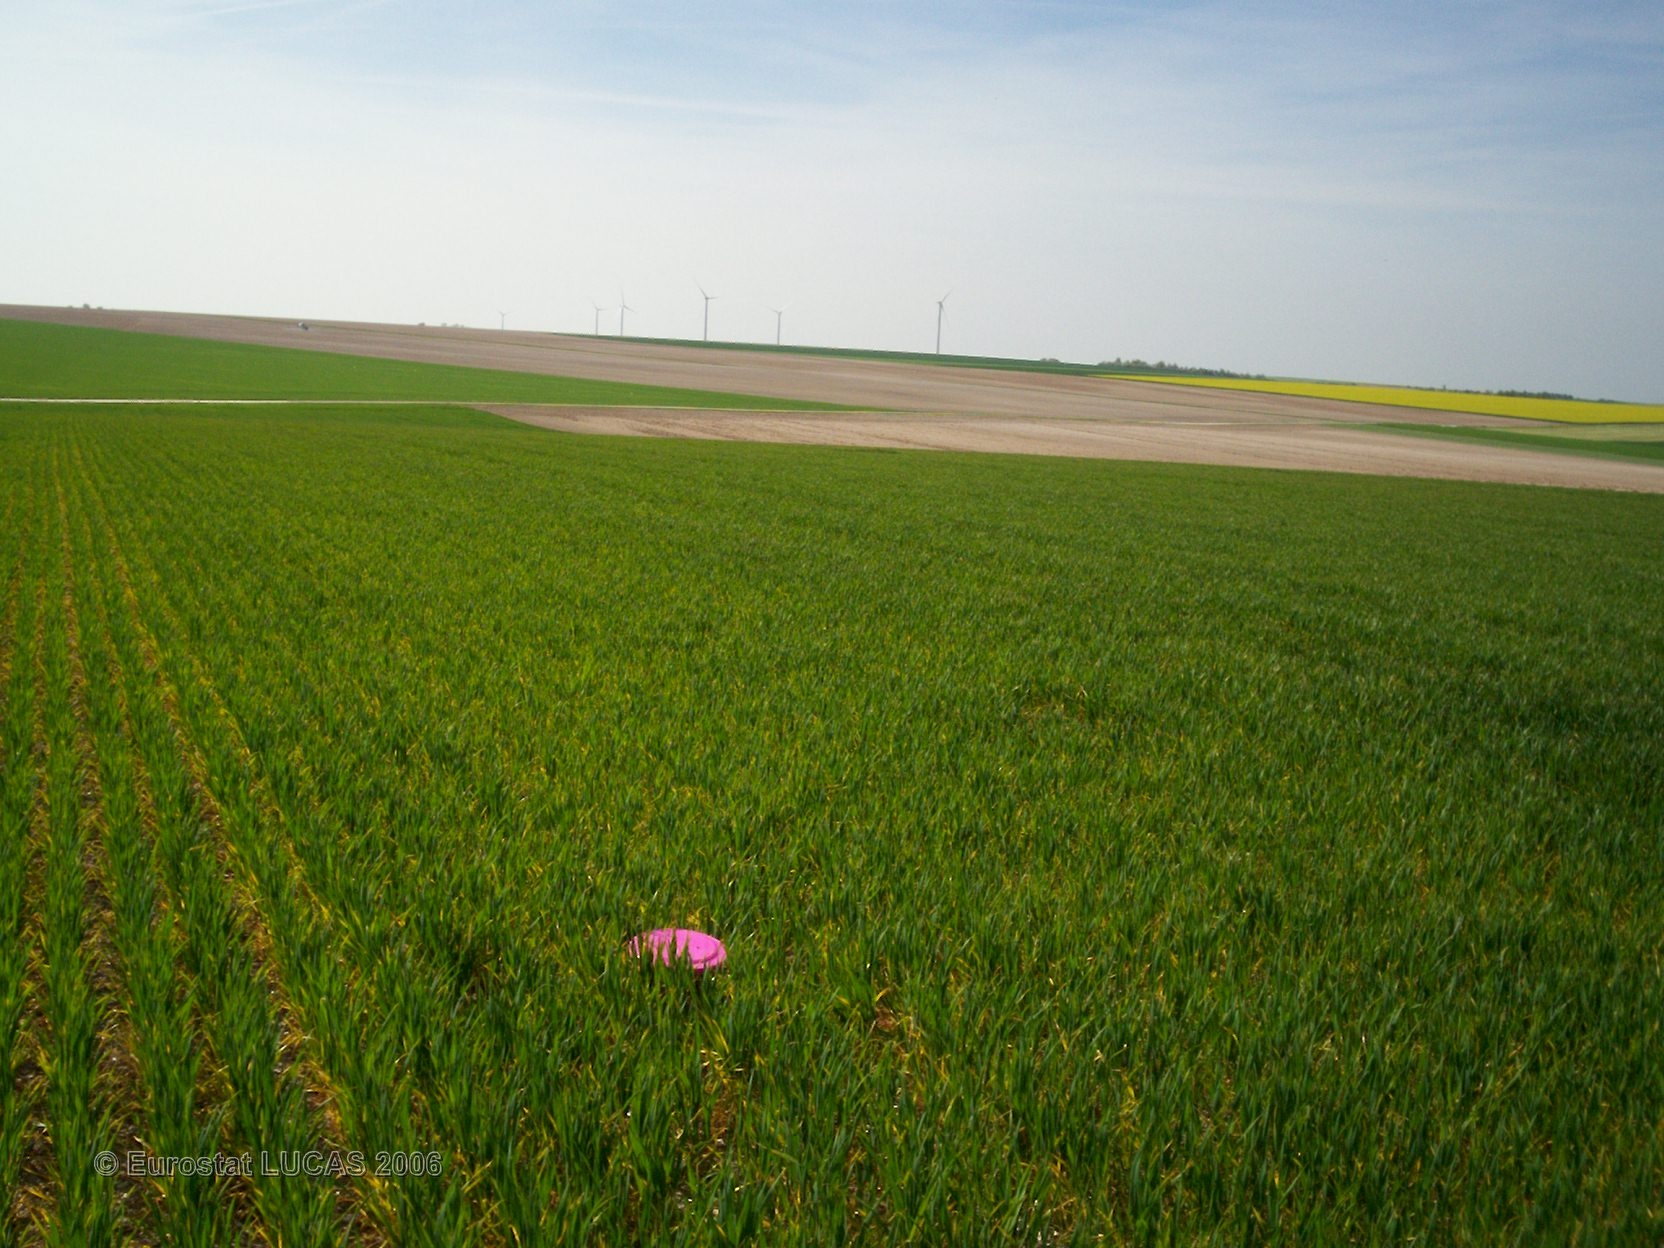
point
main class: Cropland
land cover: Common wheat
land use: Agriculture (excluding fallow land and kitchen gardens)
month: May
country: FR
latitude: 48.8565
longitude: 4.3947
